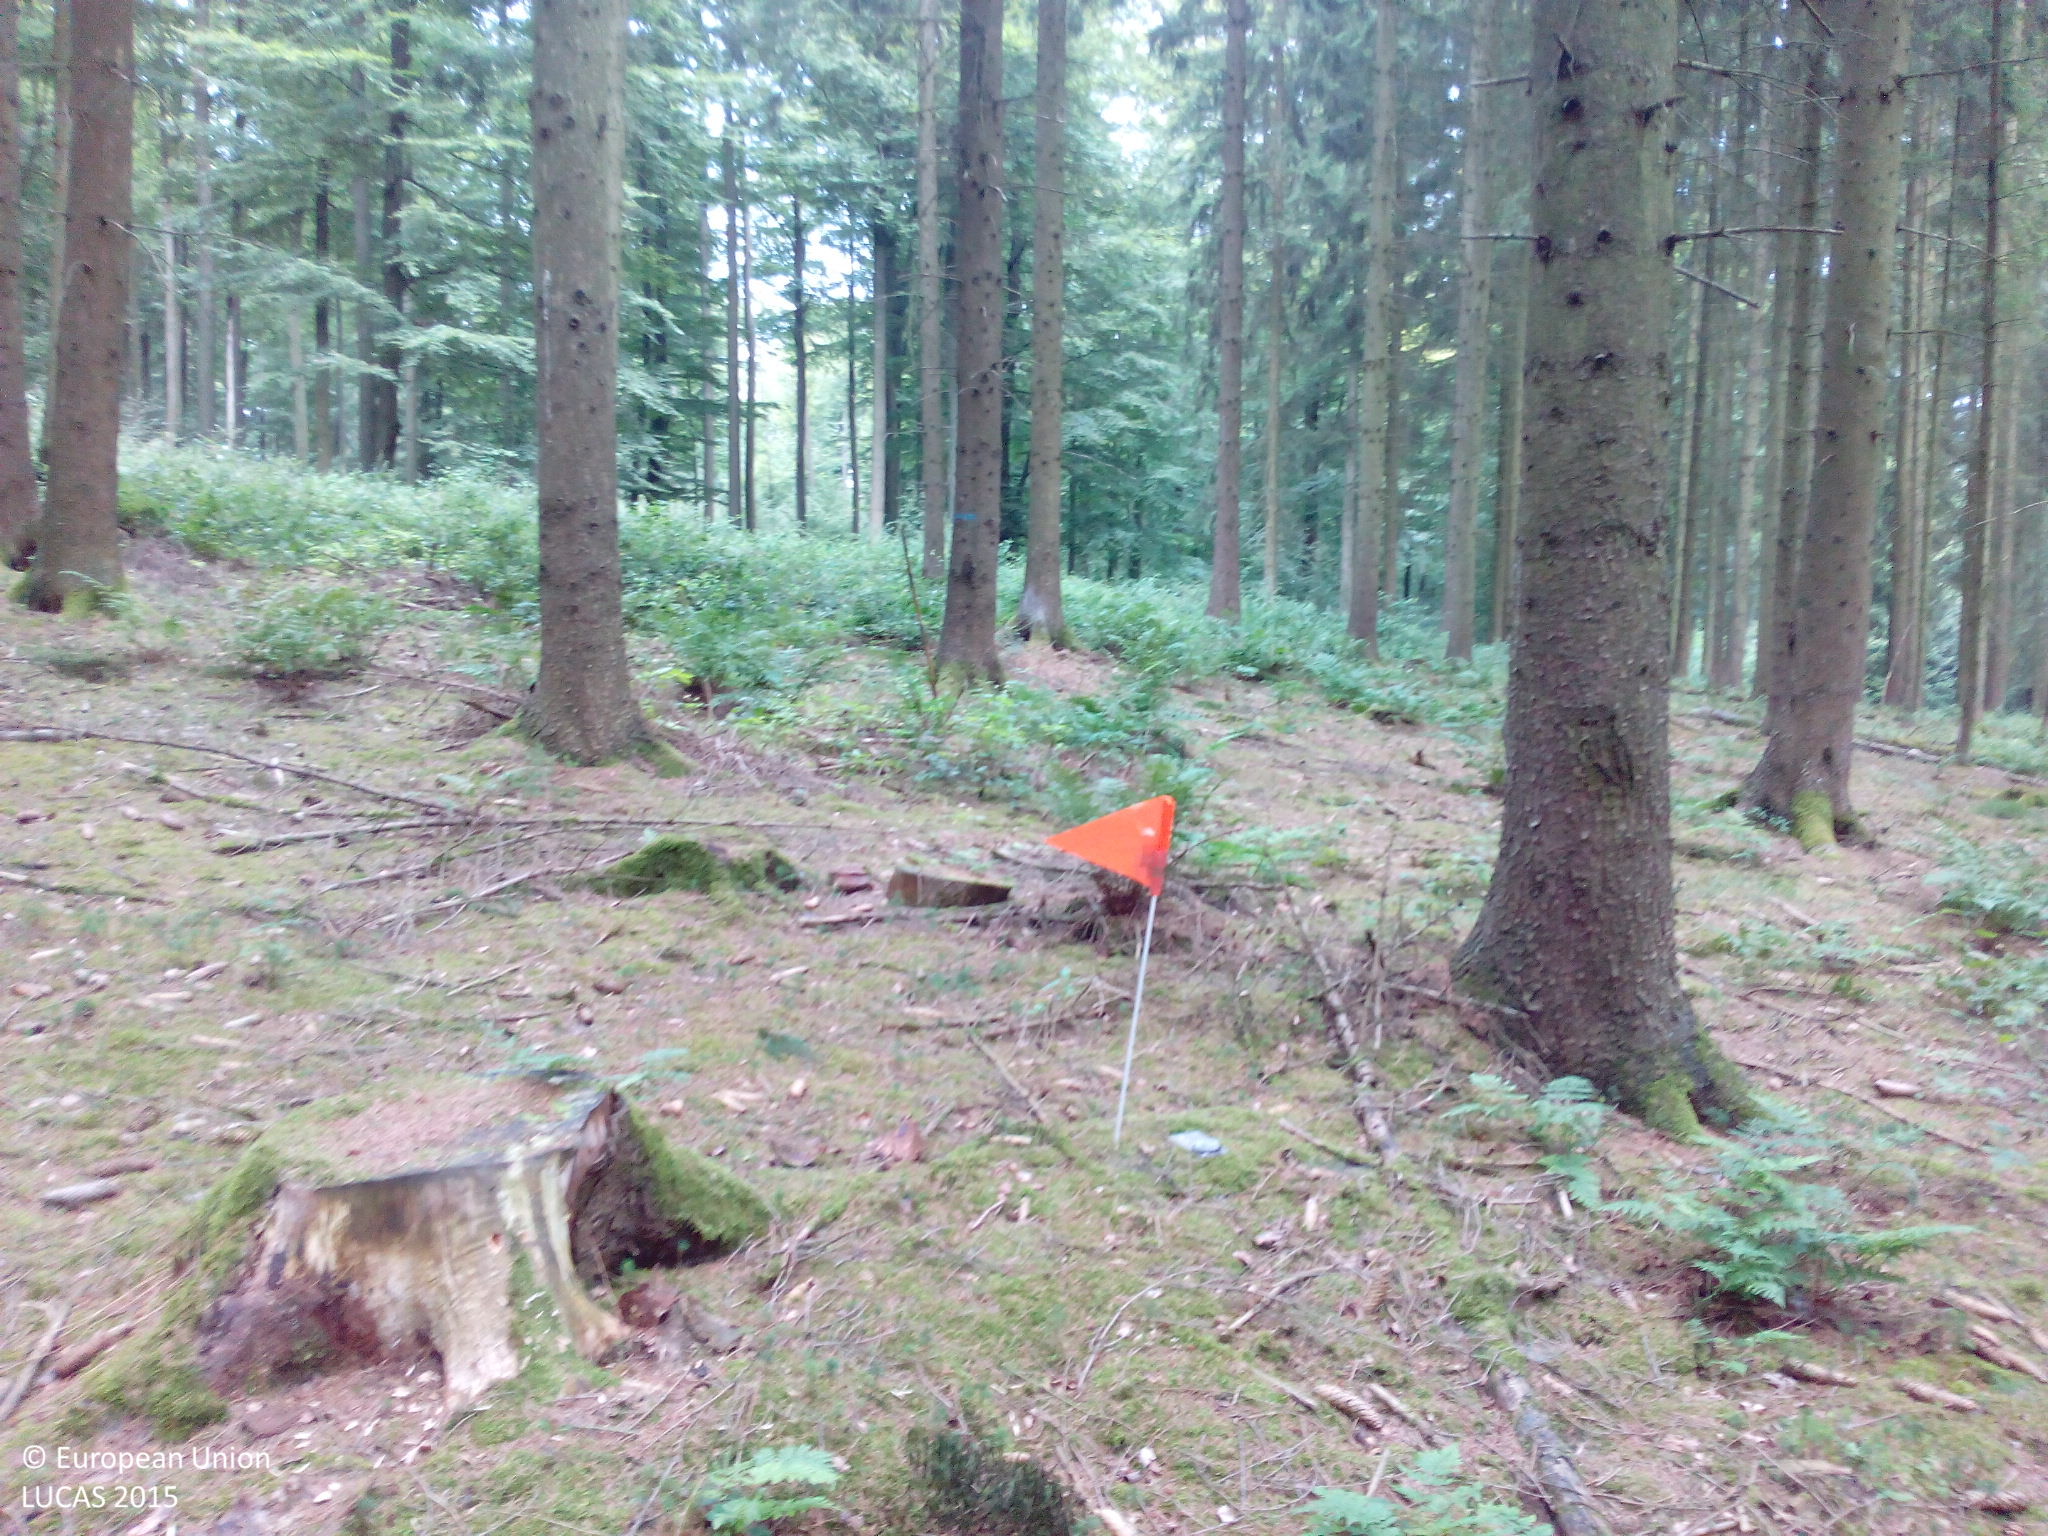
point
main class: Woodland
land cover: Spruce dominated coniferous woodland
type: hemiboreal forest and nemoral coniferous forest and mixed broadleaved-coniferous forest
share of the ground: > 75 %
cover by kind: coniferous forest trees 95 %, herbaceous plants 5 %
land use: Forestry
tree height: > 5 m
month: August
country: DE
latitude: 52.0158
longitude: 9.2863
